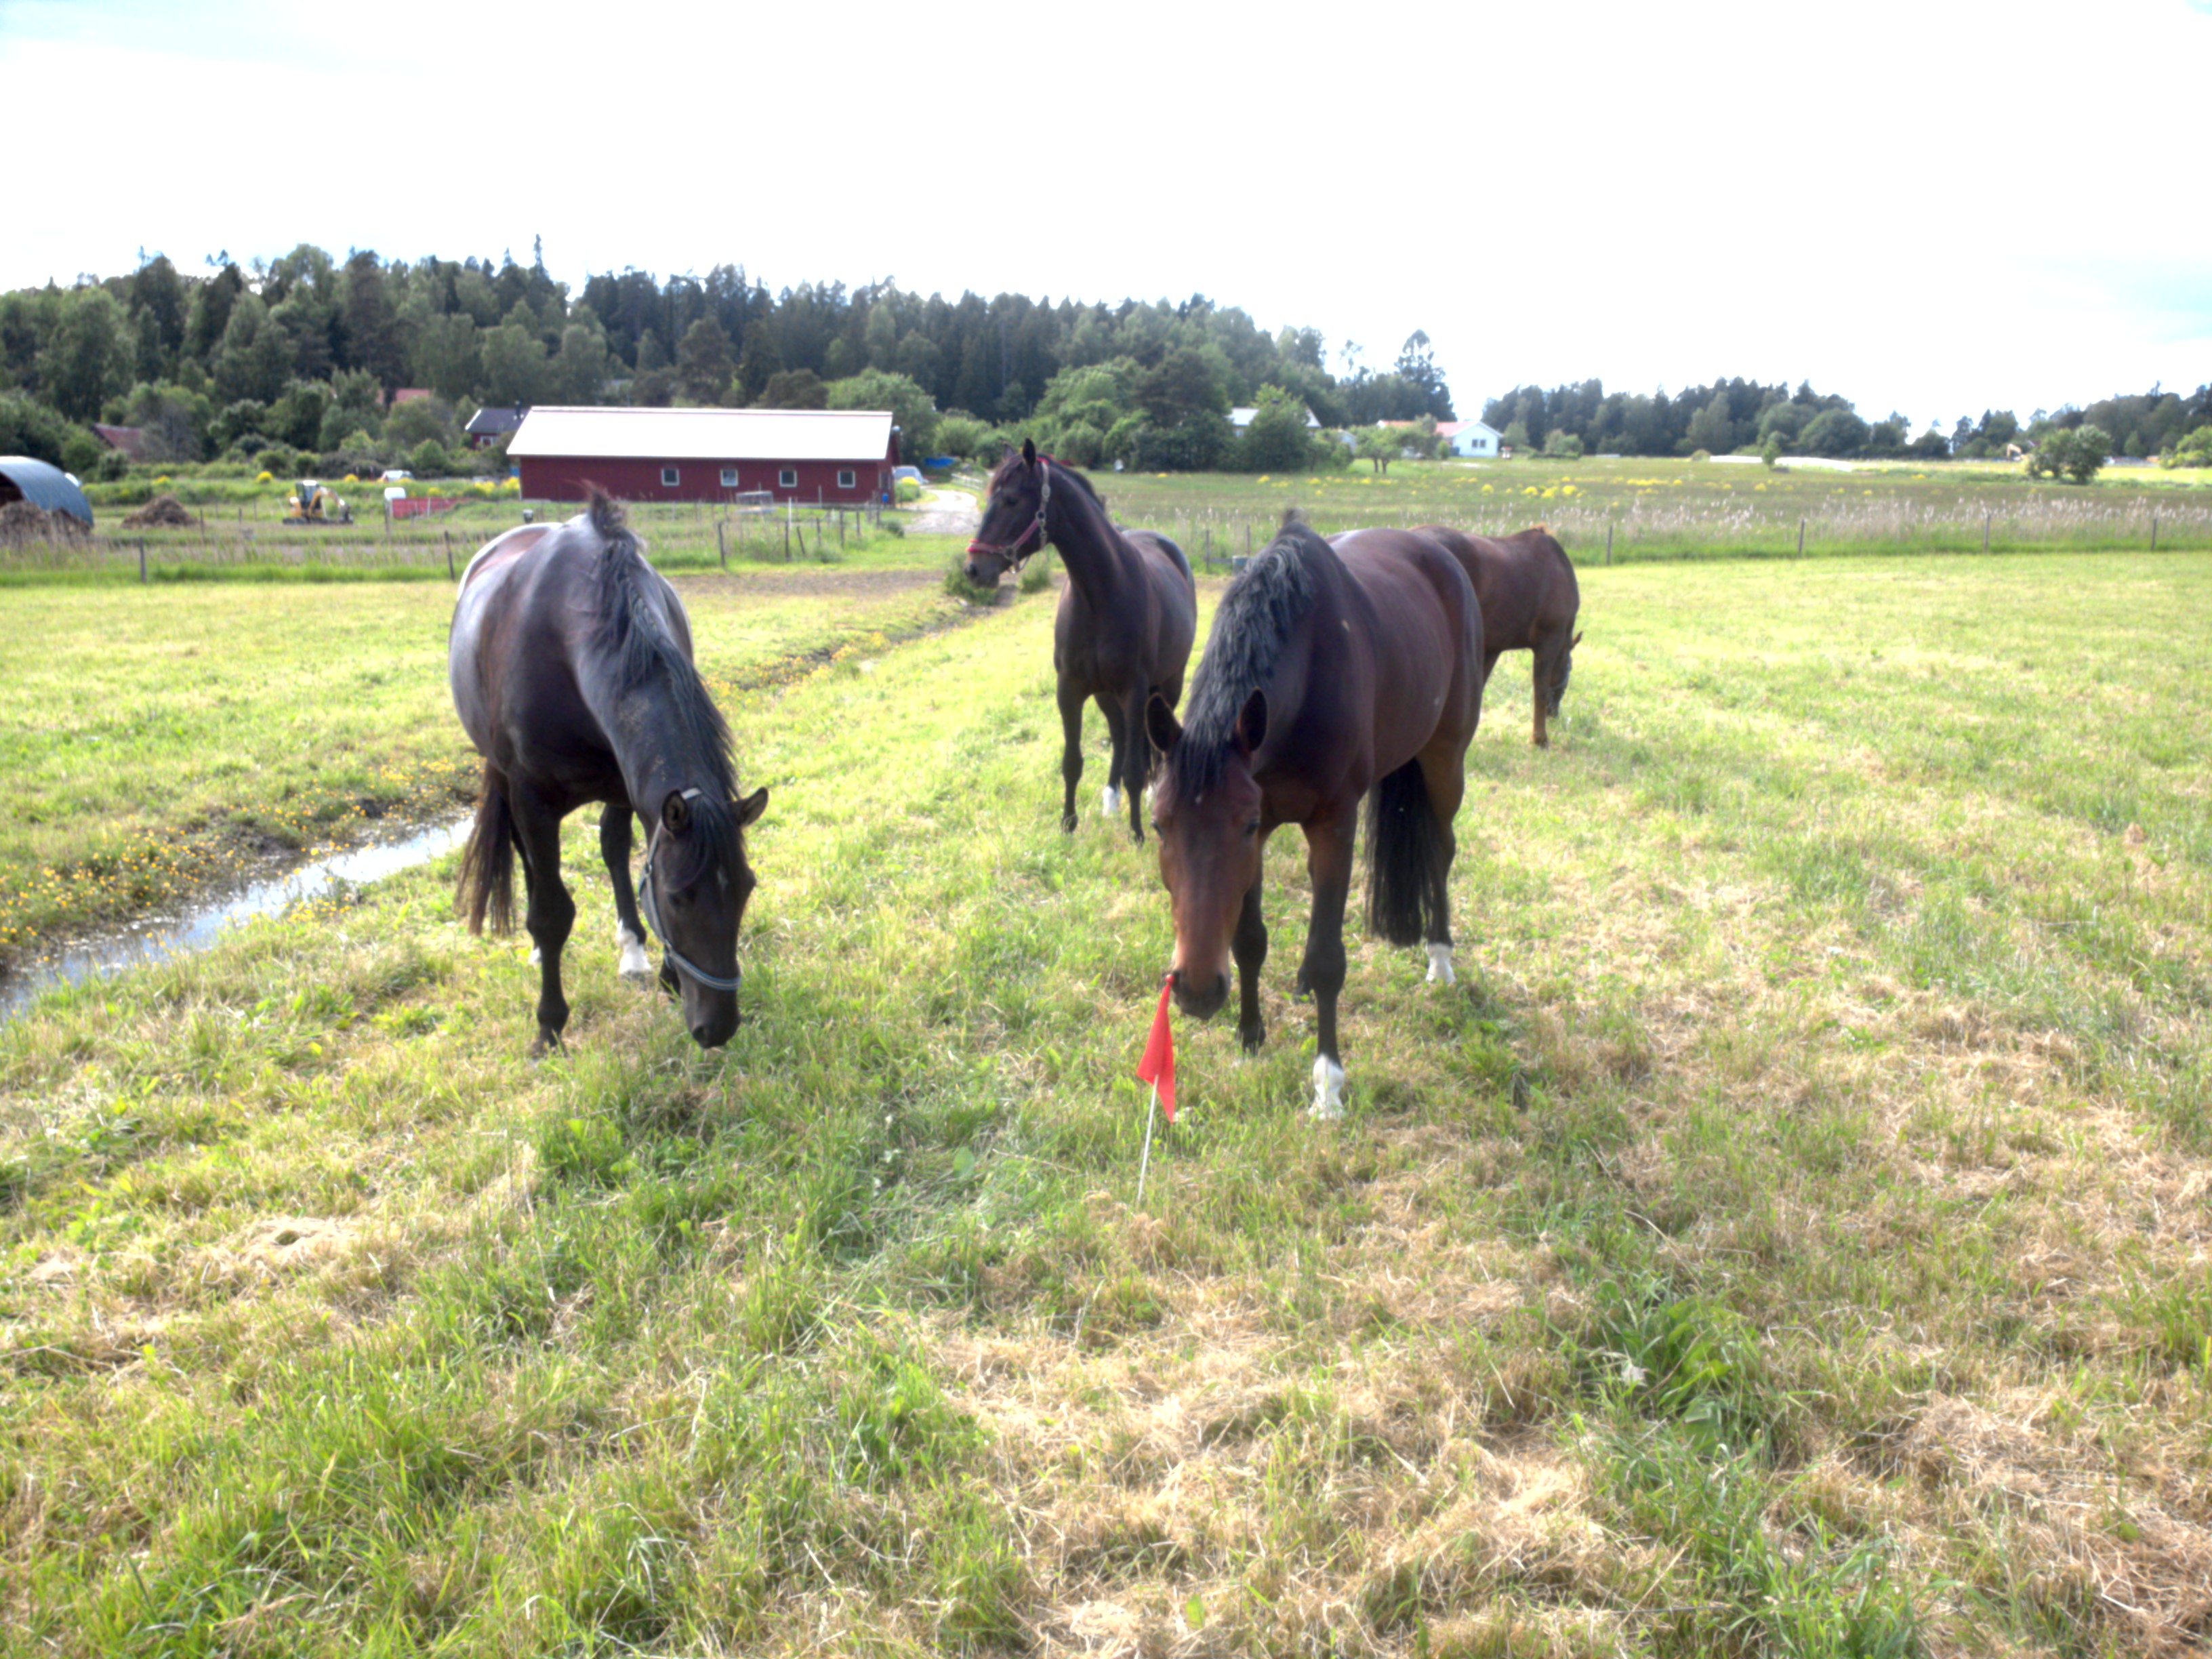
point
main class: Grassland
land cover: Grassland without tree/shrub cover
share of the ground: > 75 %
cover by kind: herbaceous plants 100 %
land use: Agriculture (excluding fallow land and kitchen gardens)
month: June
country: SE
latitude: 59.3796
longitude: 17.5826
